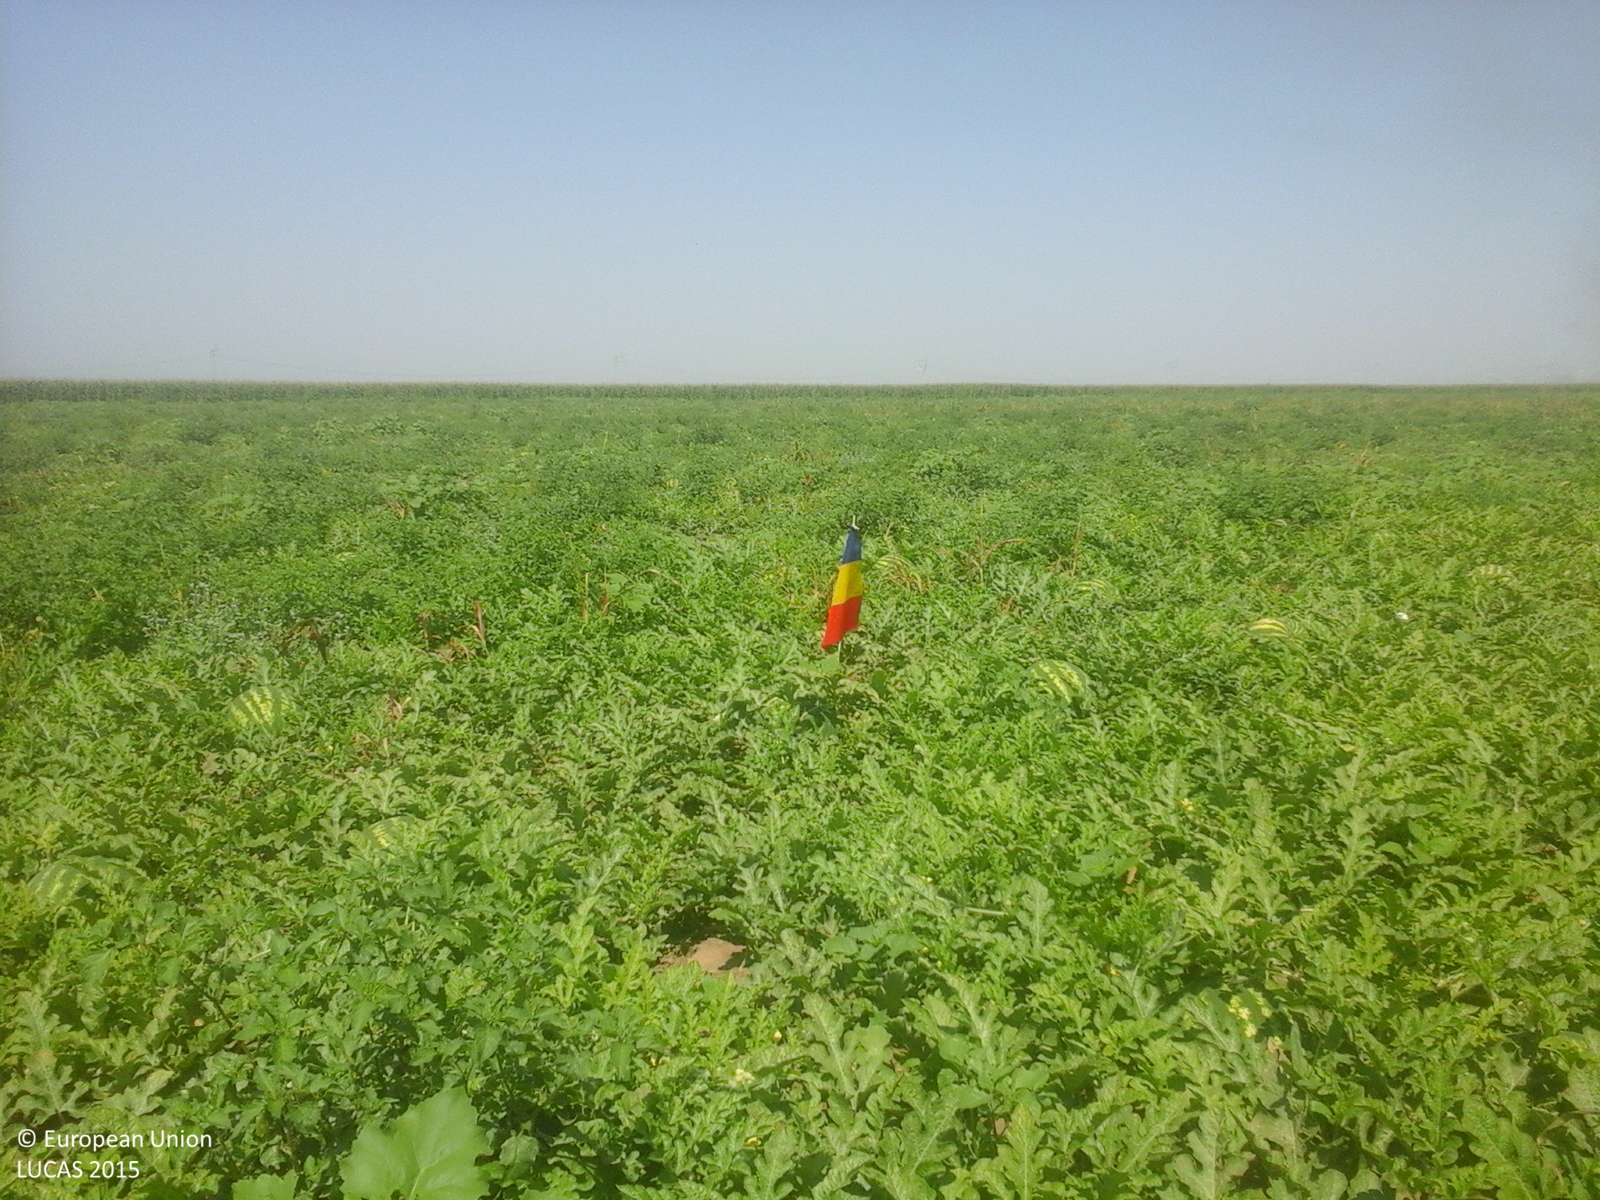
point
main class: Cropland
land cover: Other fresh vegetables
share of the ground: > 75 %
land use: Agriculture (excluding fallow land and kitchen gardens)
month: July
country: RO
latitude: 44.7891
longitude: 27.6826
